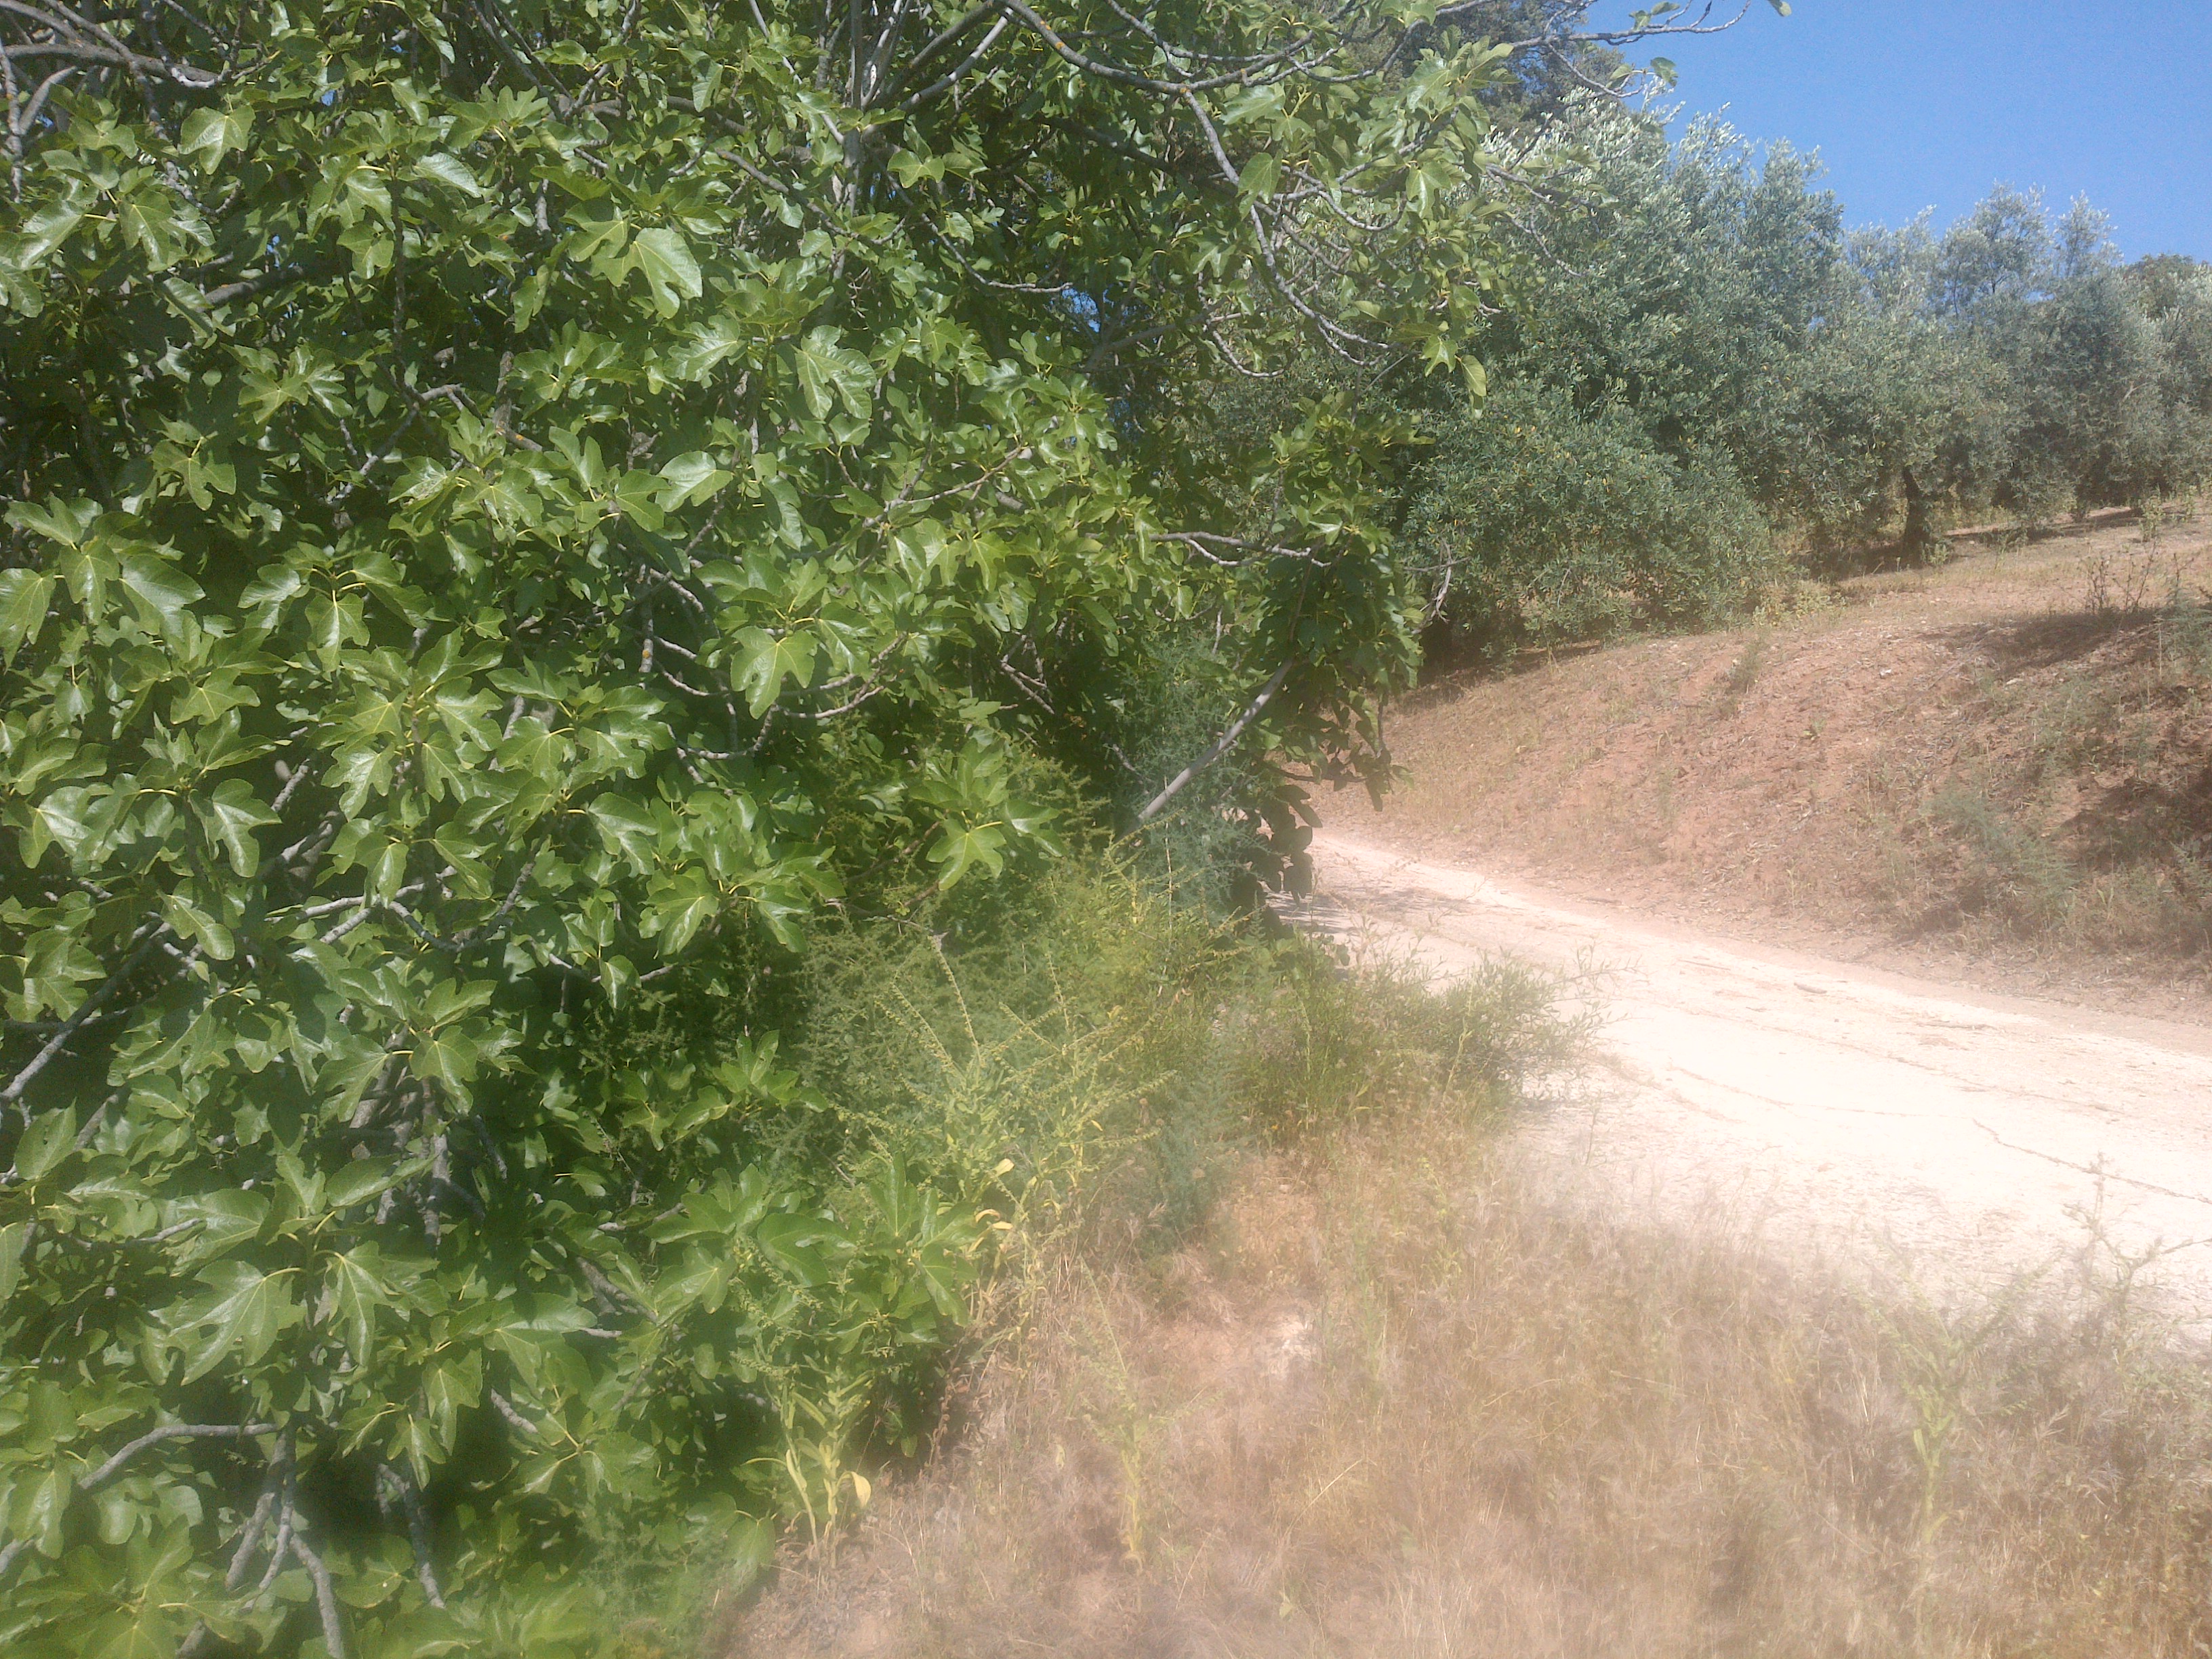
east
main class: Cropland
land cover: Olive groves
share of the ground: 25 - 50 %
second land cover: Spontaneously vegetated surfaces
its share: 10 - 25 %
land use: Agriculture (excluding fallow land and kitchen gardens)
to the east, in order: Olive groves; Spontaneously vegetated surfaces; Single bushes/trees; Tracks; Single bushes/trees; Artificial constructions in urban areas; Shrubland with sparse tree cover; Olive groves
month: May
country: ES
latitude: 37.4519
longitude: -4.4154
